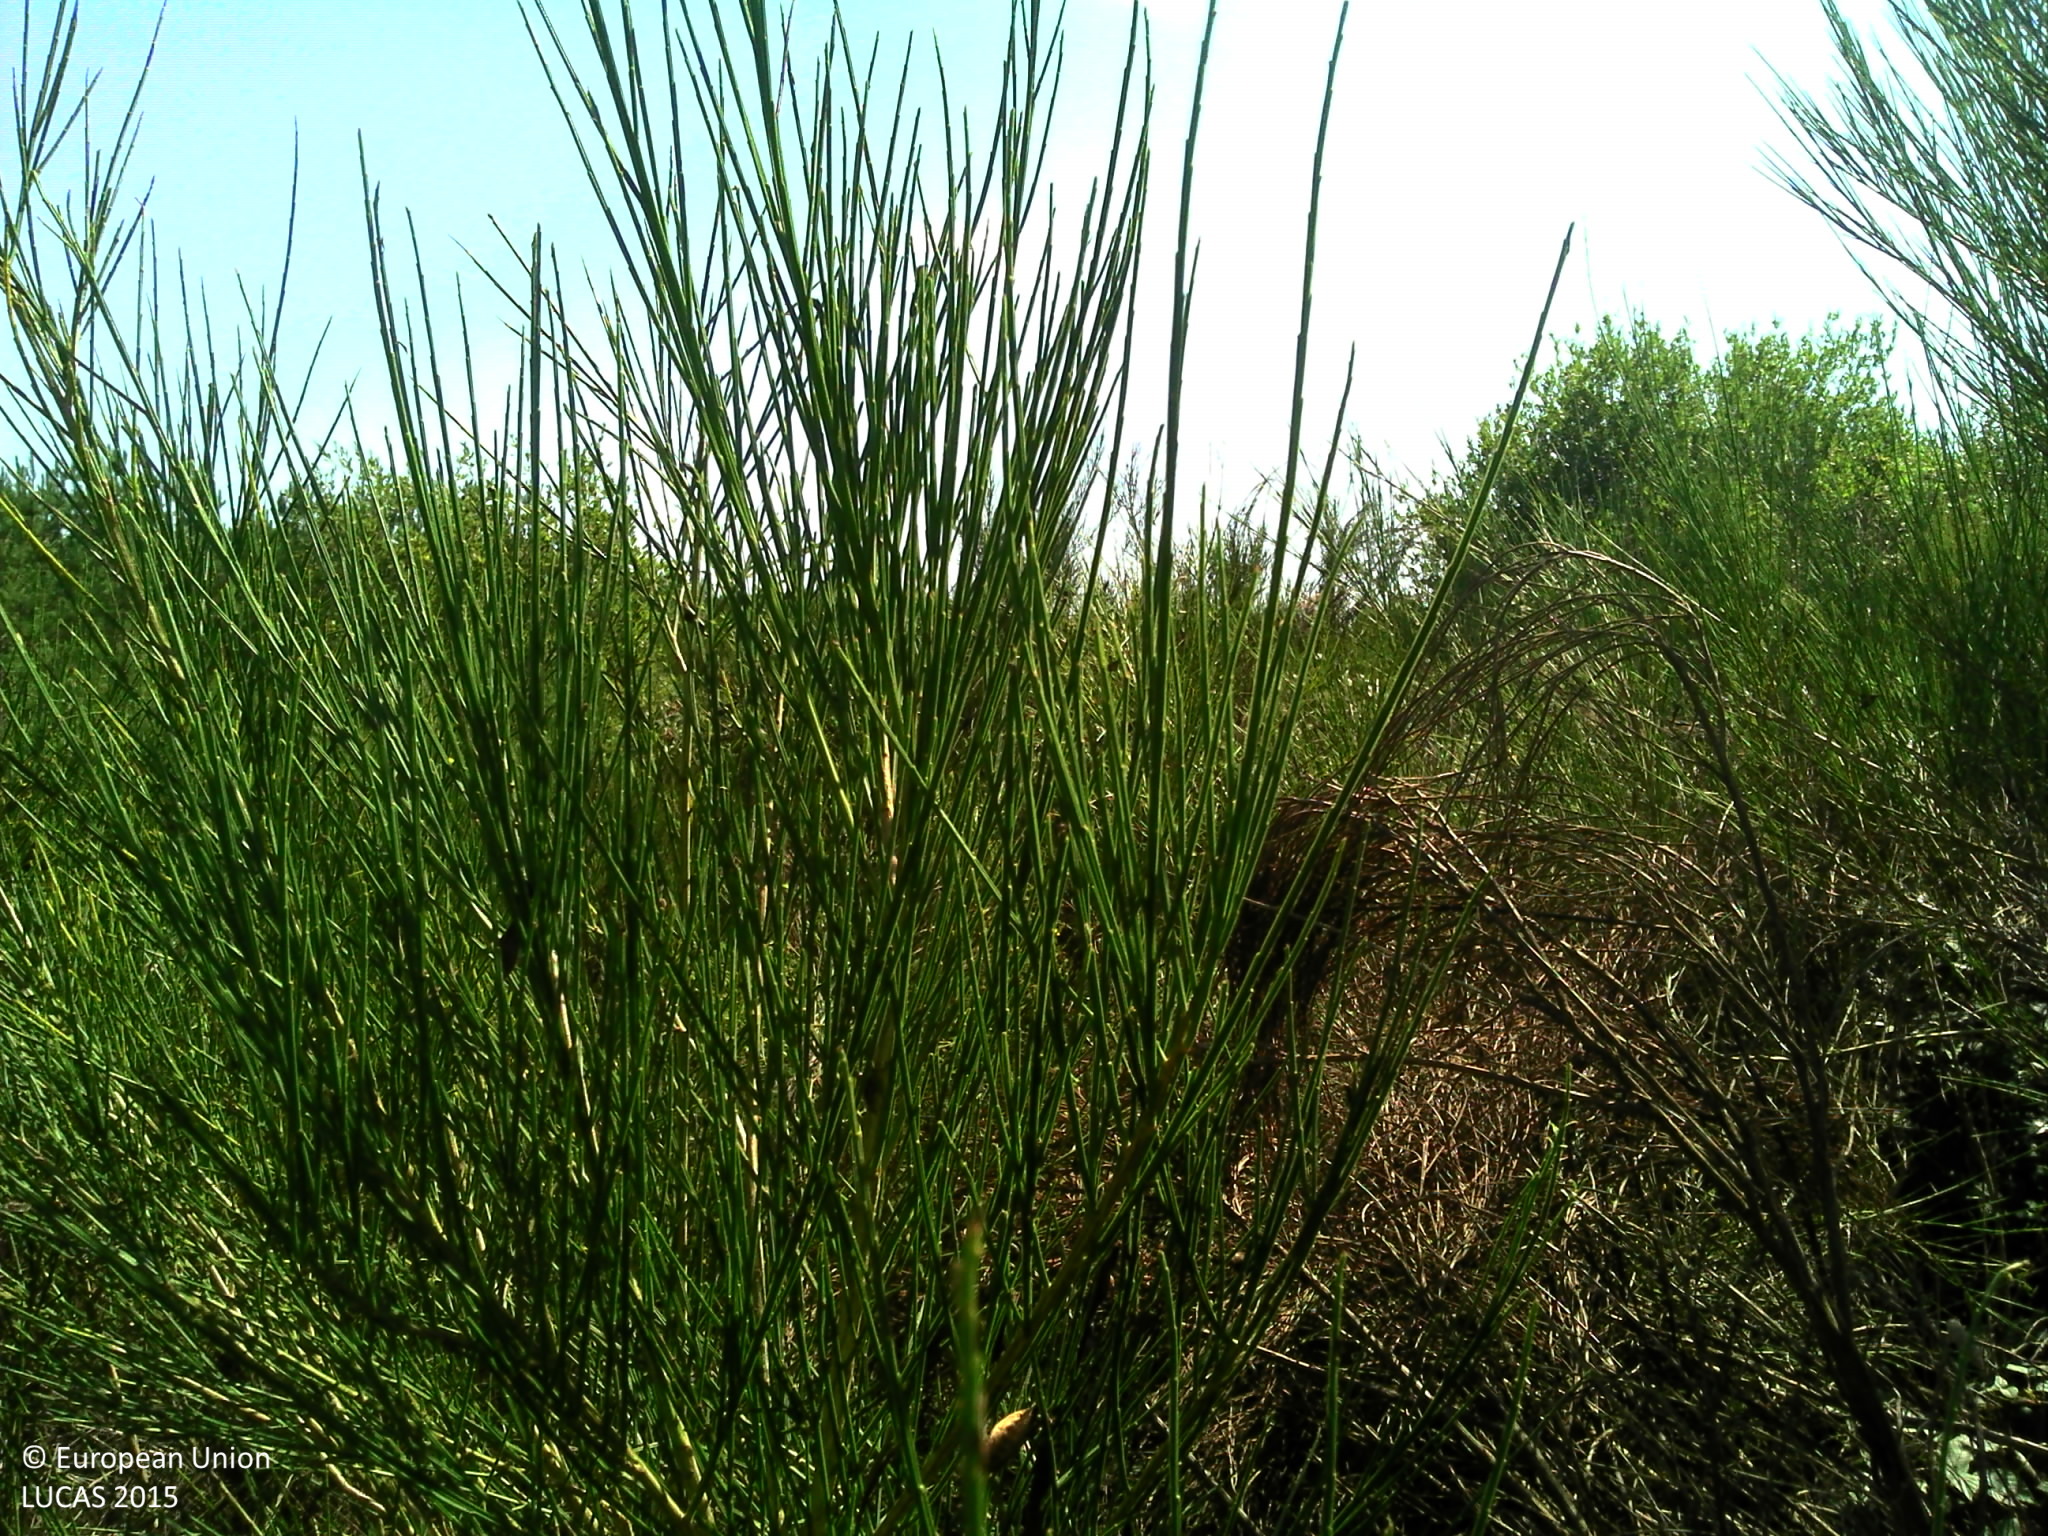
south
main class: Woodland
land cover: Pine dominated coniferous woodland
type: exotic forest
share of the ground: > 75 %
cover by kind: coniferous forest trees 70 %, shrubs 20 %, herbaceous plants 10 %
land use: Forestry
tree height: < 5 m
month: August
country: FR
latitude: 44.9813
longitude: 0.4654
